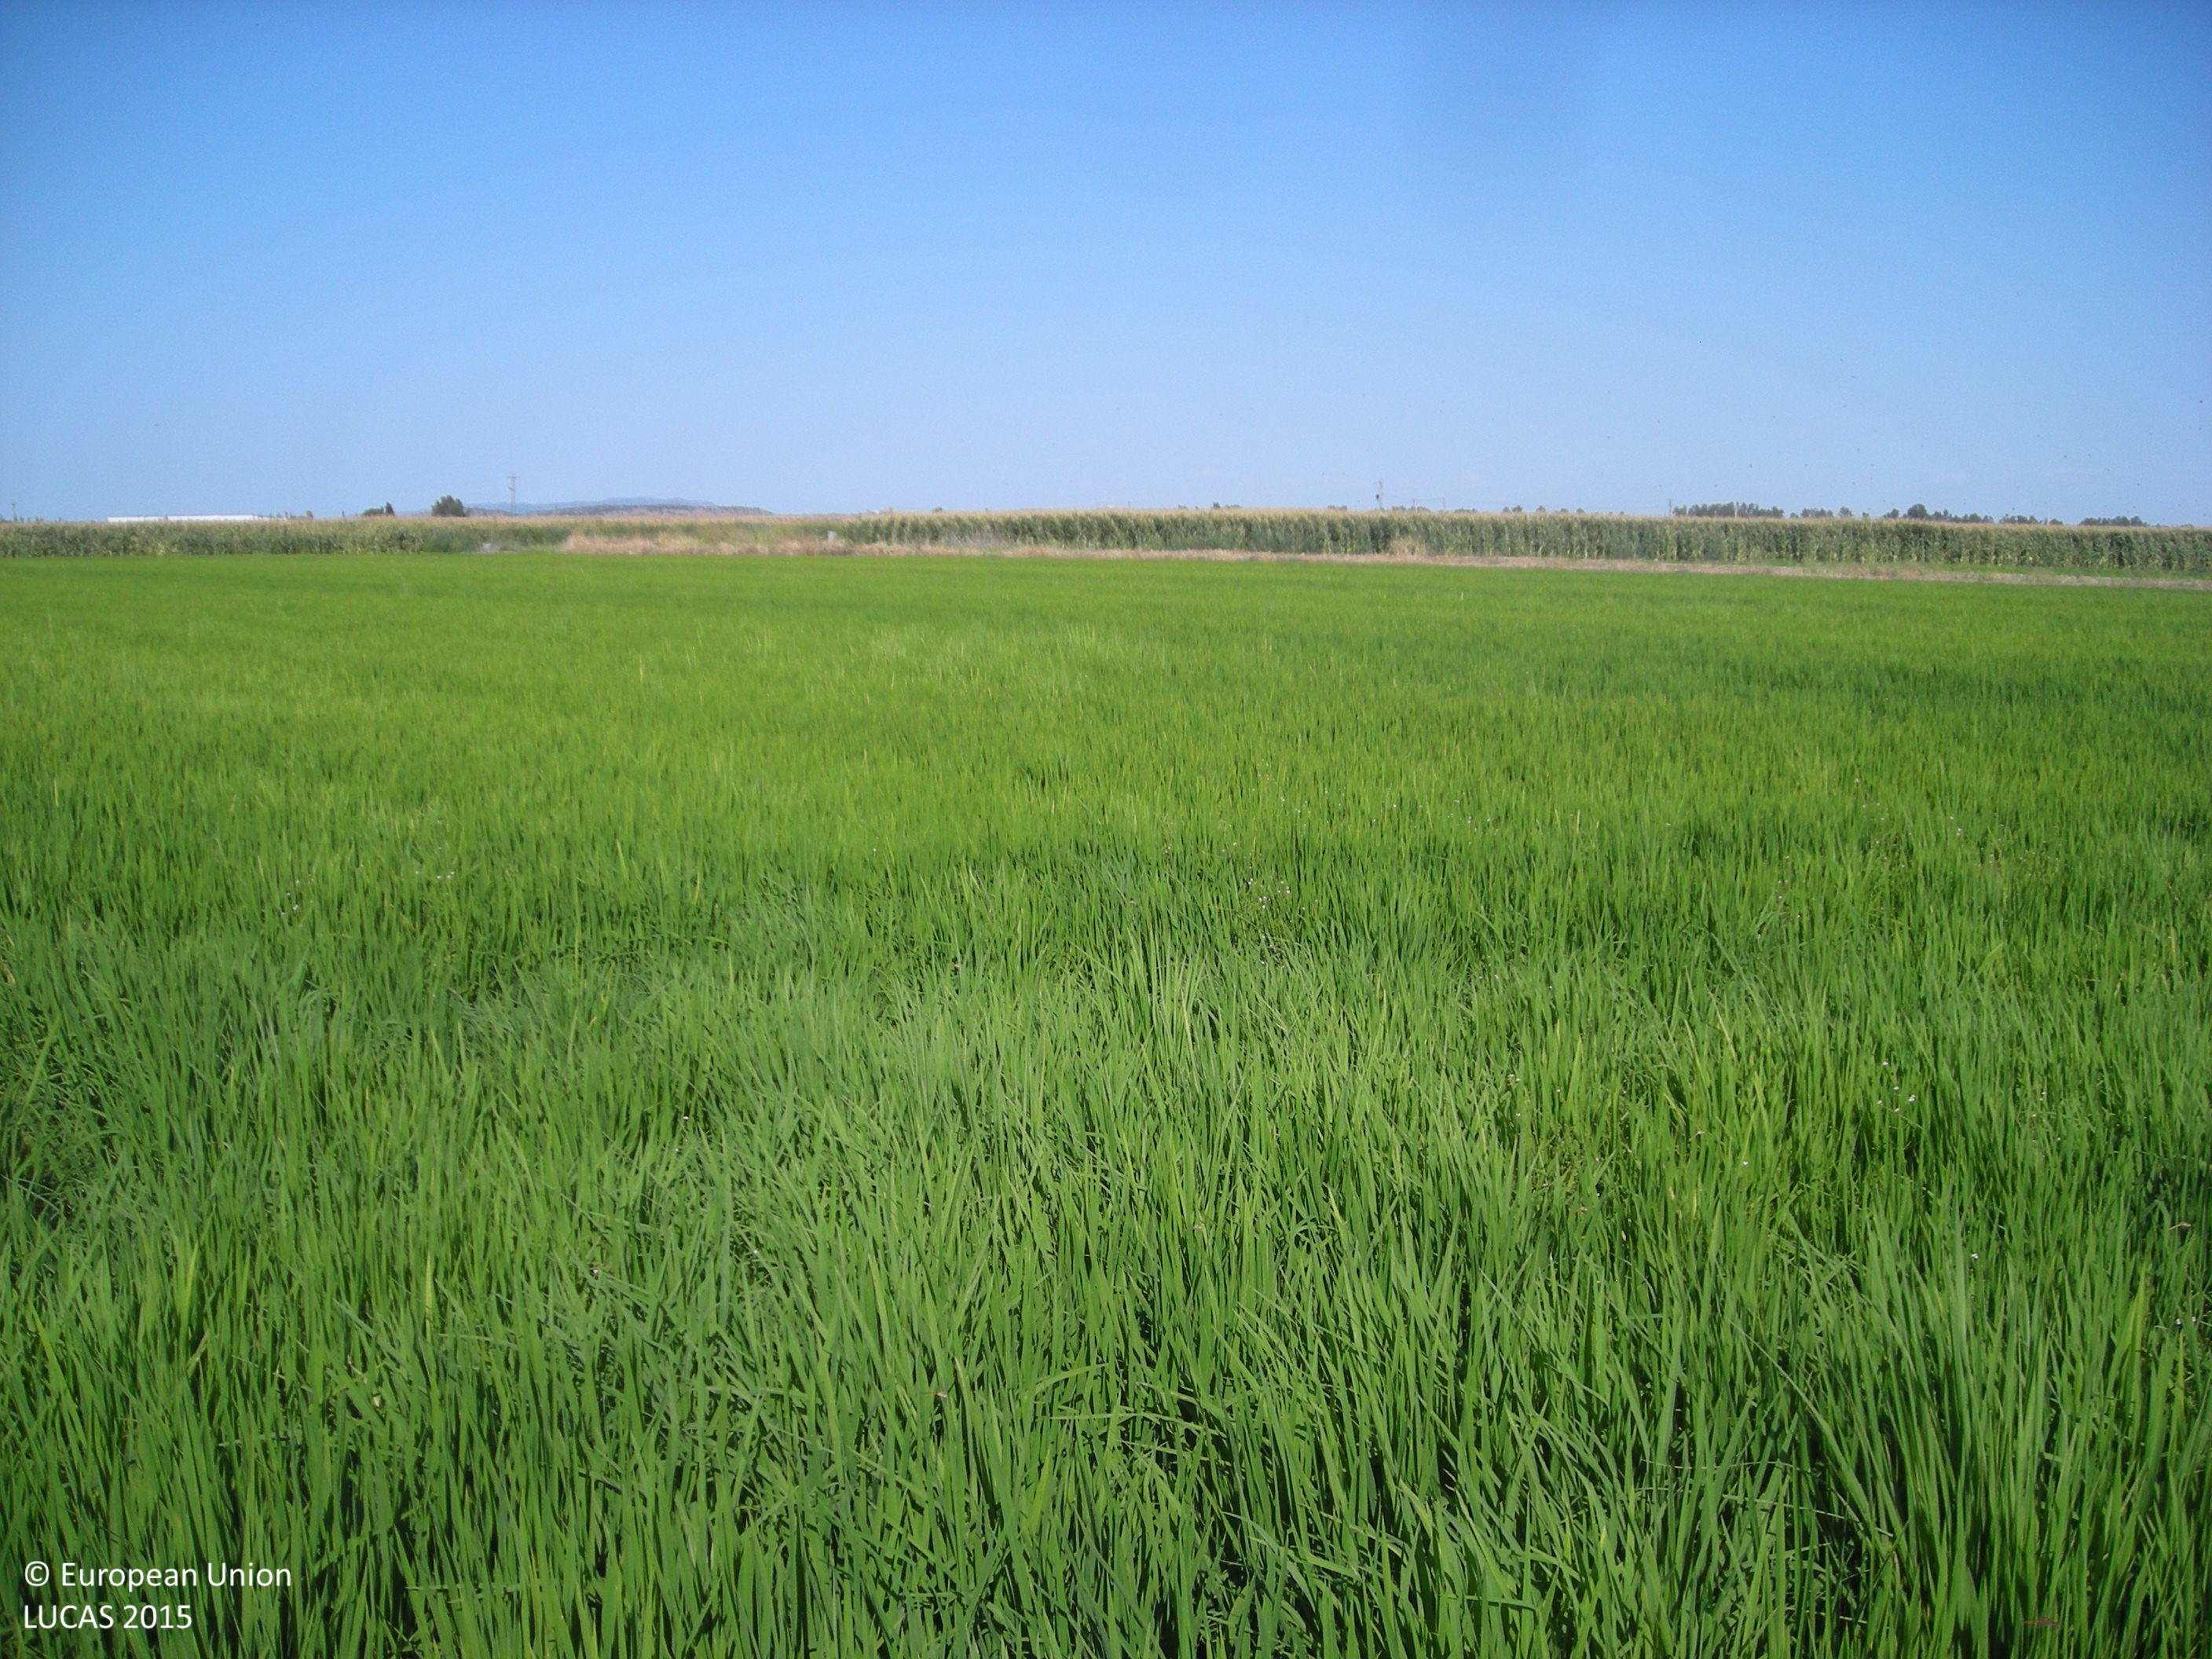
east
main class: Cropland
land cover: Rice
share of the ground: > 75 %
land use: Agriculture (excluding fallow land and kitchen gardens)
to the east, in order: Rice; Grass margins; Tracks; Grass margins; Ditches and canals; Grass margins; Ditches and canals; Grass margins; Tracks; Grass margins; Maize
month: July
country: ES
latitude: 39.0189
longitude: -5.8856
